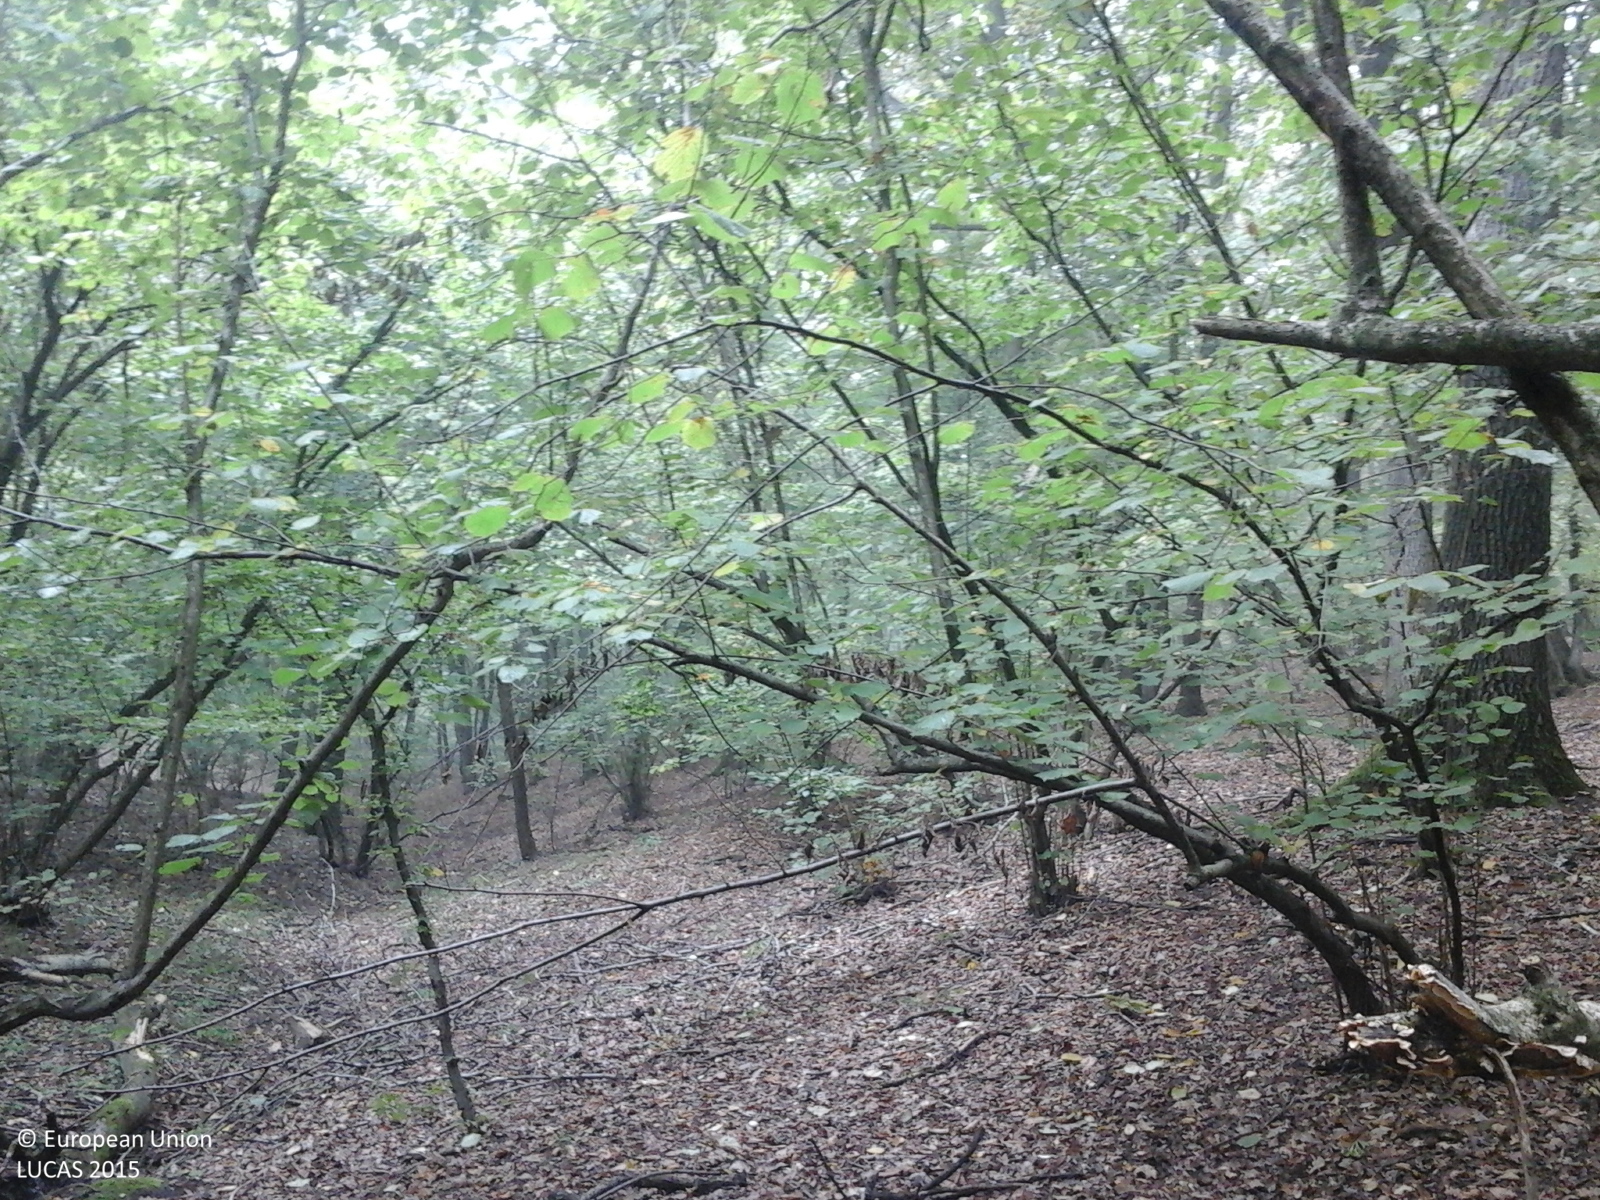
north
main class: Woodland
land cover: Broadleaved woodland
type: mesophytic deciduous forest
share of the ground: > 75 %
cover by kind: broadleaved forest trees 100 %
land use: Forestry
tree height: > 5 m
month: October
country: RO
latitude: 46.3409
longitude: 24.2555
